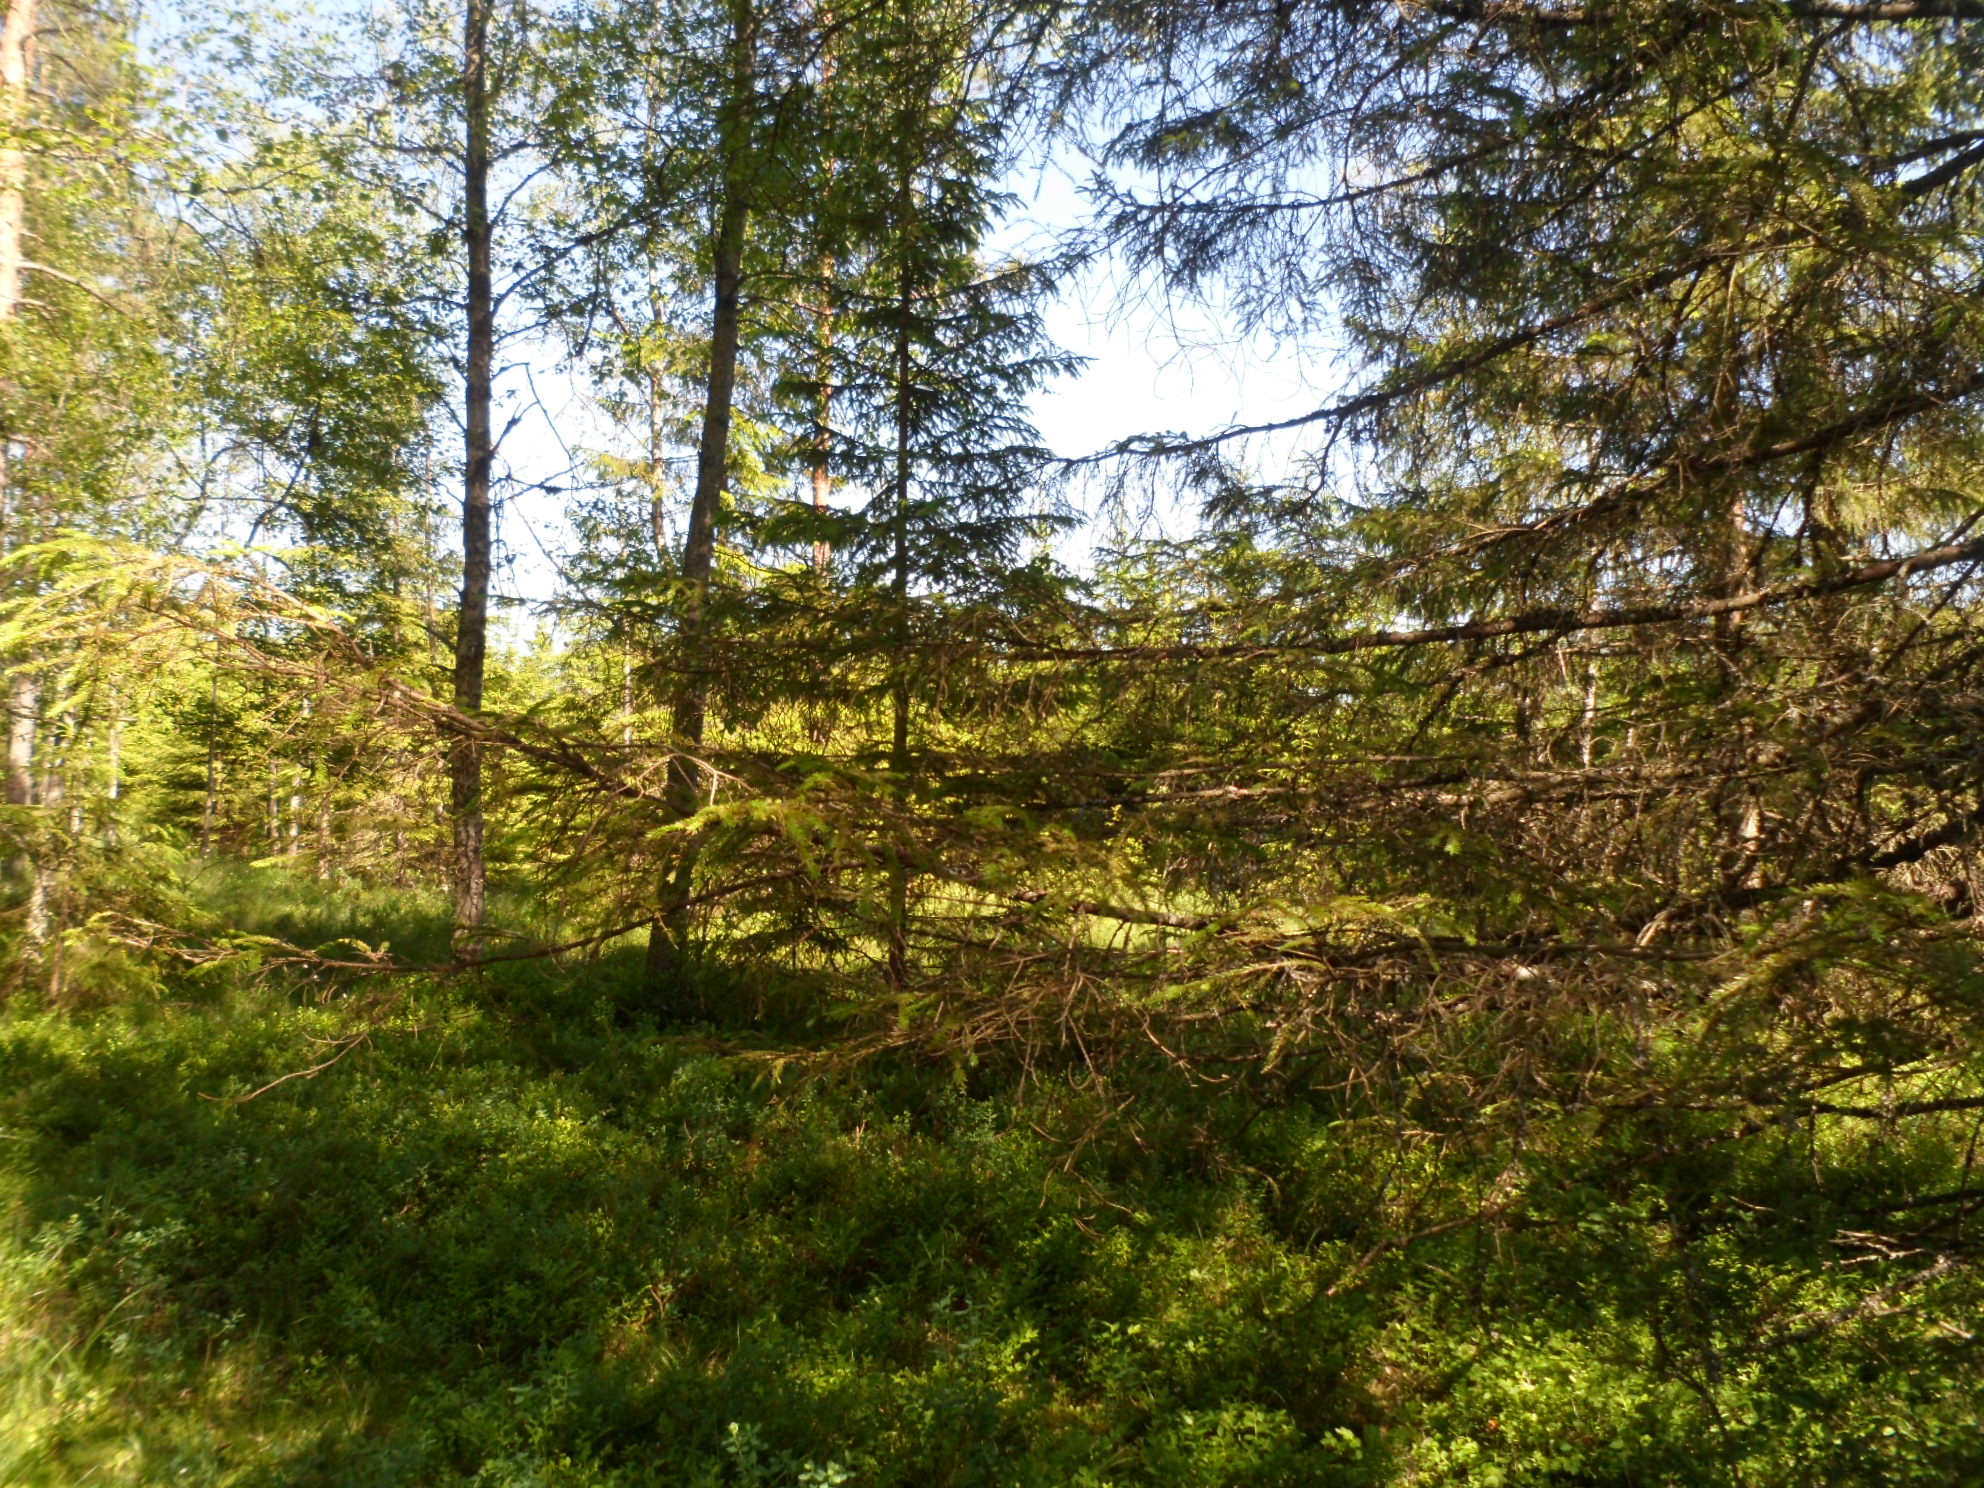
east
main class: Woodland
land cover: Spruce dominated coniferous woodland
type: boreal forest
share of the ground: 50 - 75 %
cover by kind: coniferous forest trees 50 %, shrubs 30 %, lichens and mosses 10 %, broadleaved forest trees 5 %, herbaceous plants 5 %
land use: Forestry
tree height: > 5 m
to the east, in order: Spruce dominated coniferous woodland; Spruce dominated mixed woodland; Ditches and canals; Spruce dominated coniferous woodland; Spruce dominated mixed woodland; Dry stone walls; Spruce dominated coniferous woodland; Ditches and canals; Spruce dominated mixed woodland; Shrubland with sparse tree cover; Pine dominated coniferous woodland
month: July
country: SE
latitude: 57.4940
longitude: 14.5506
